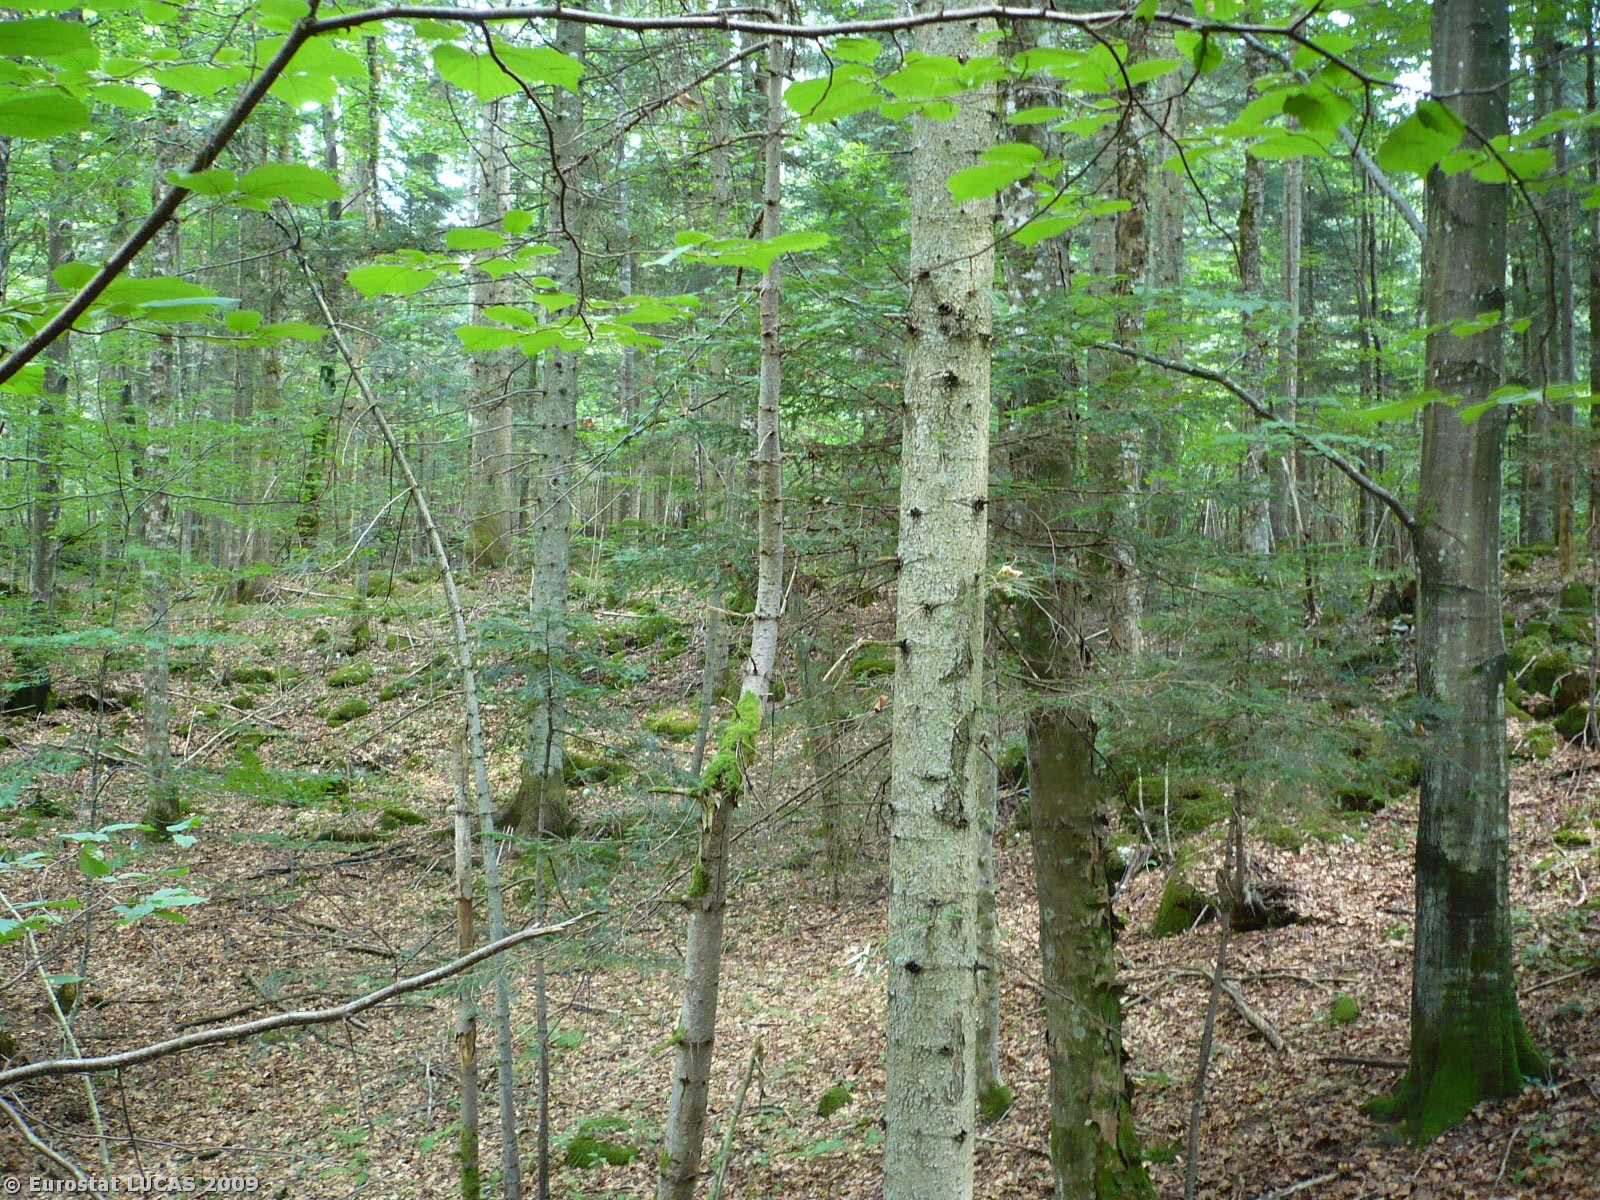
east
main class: Woodland
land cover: Mixed woodland
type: beech forest
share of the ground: > 75 %
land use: Forestry
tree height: > 5 m
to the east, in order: Mixed woodland; Coniferous woodland; Tracks; Coniferous woodland; Mixed woodland; Spontaneously vegetated surfaces; Tracks; Coniferous woodland
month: August
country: SI
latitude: 45.8484
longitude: 14.3357
